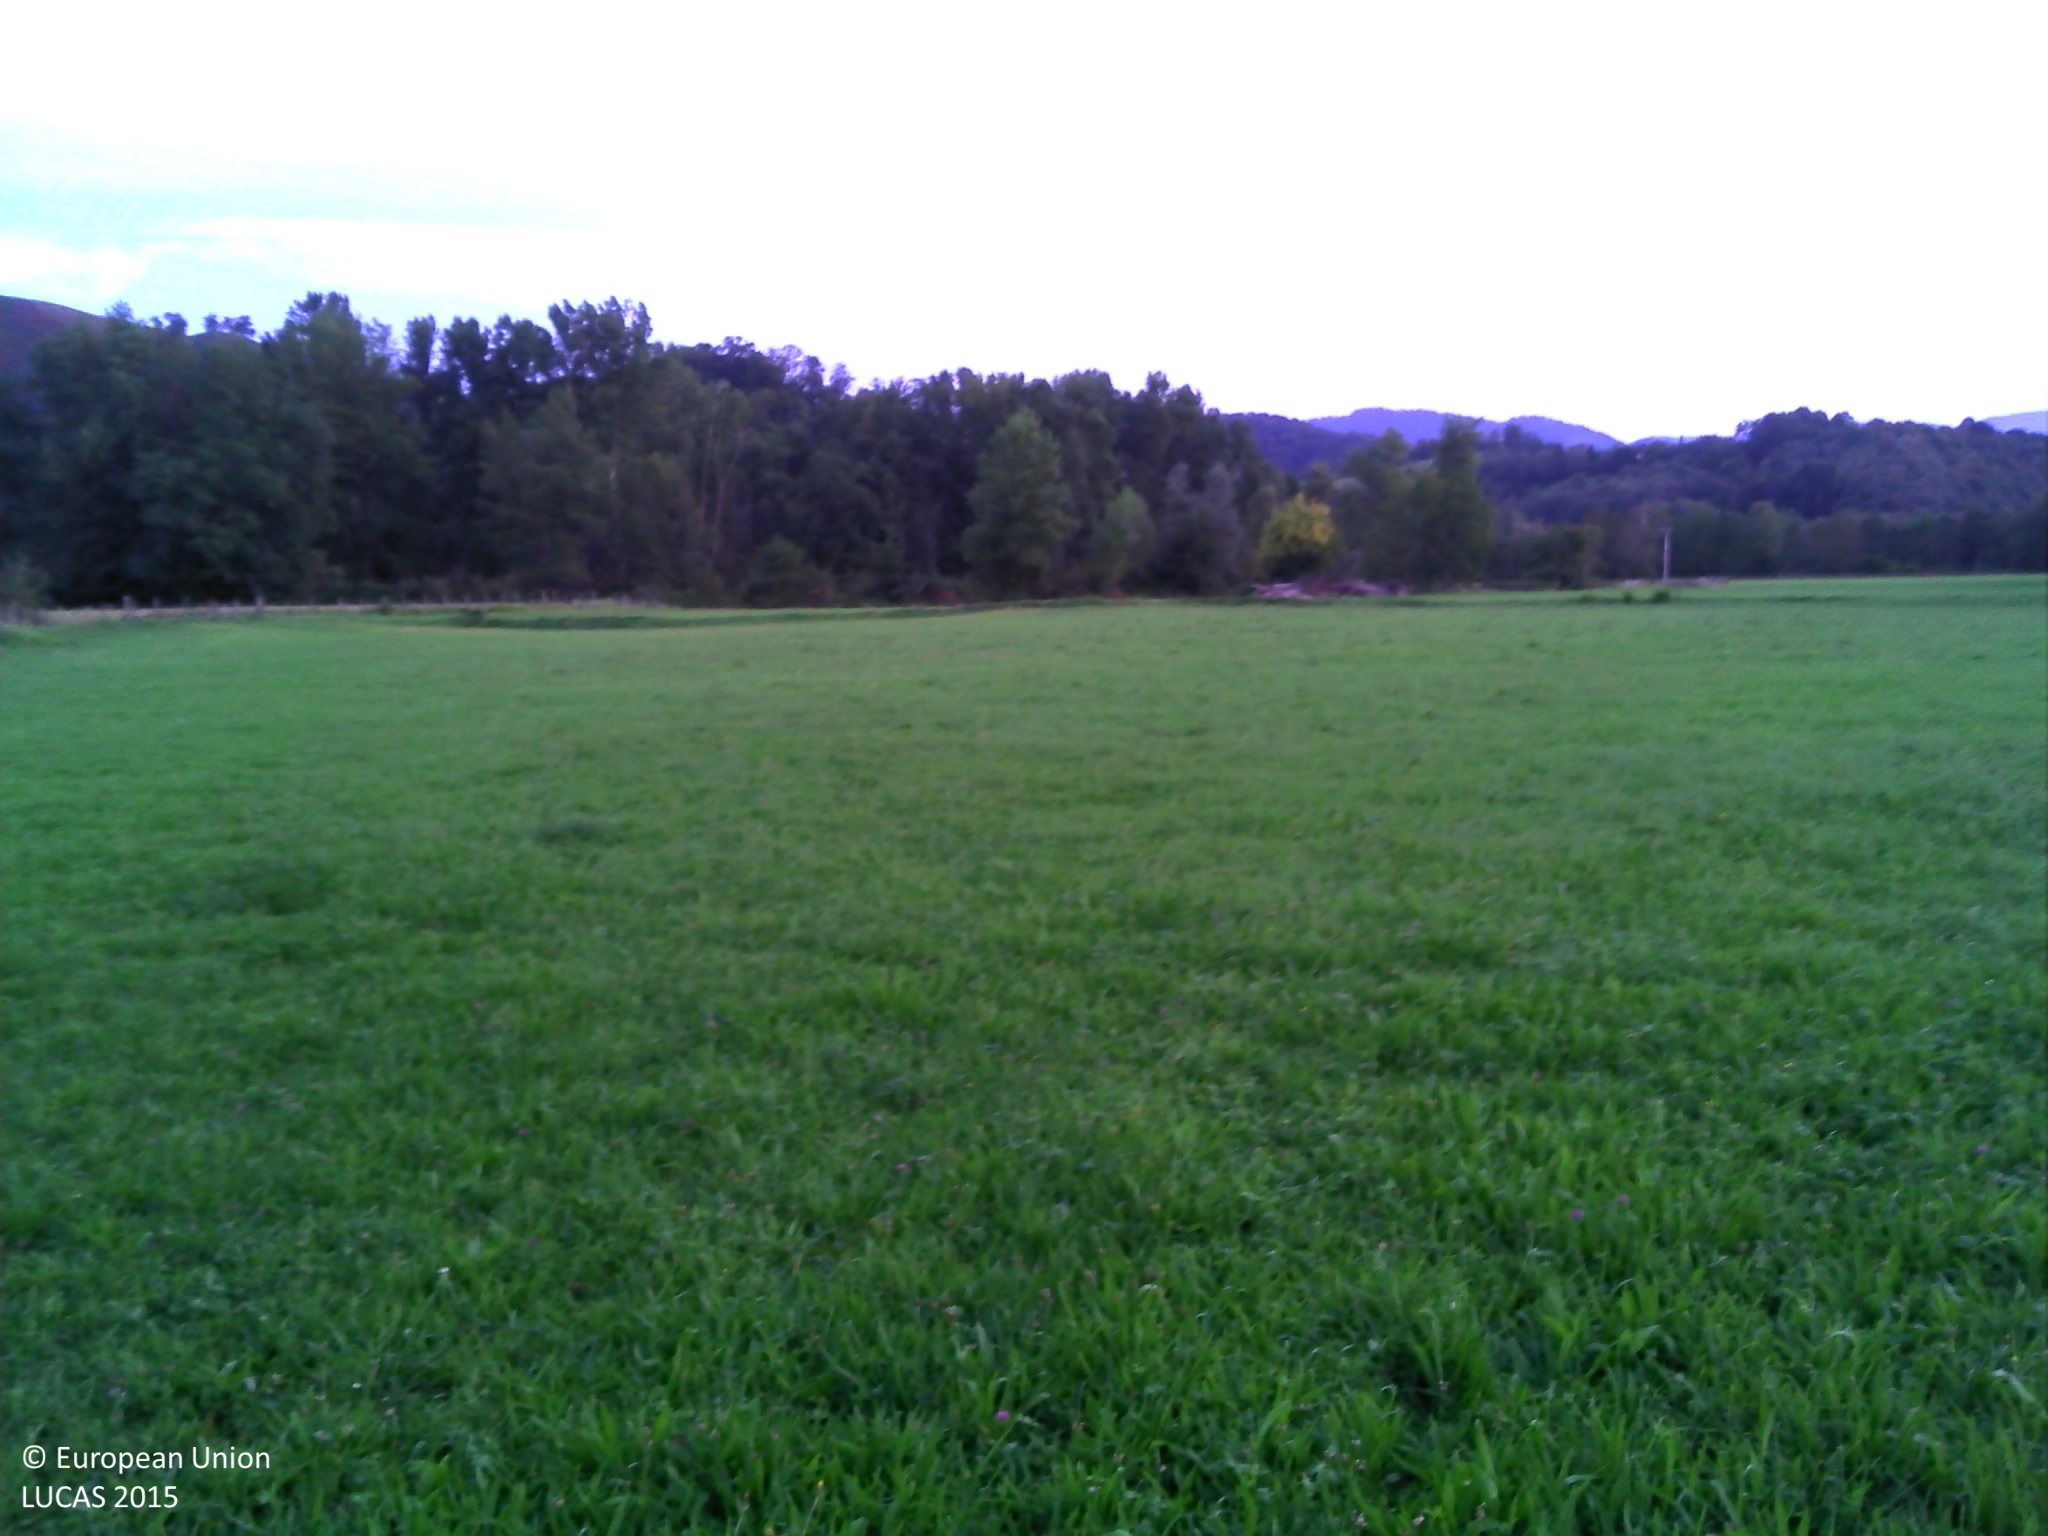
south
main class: Grassland
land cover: Grassland without tree/shrub cover
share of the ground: > 75 %
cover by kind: herbaceous plants 100 %
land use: Agriculture (excluding fallow land and kitchen gardens)
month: September
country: FR
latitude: 43.1418
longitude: -0.6927
